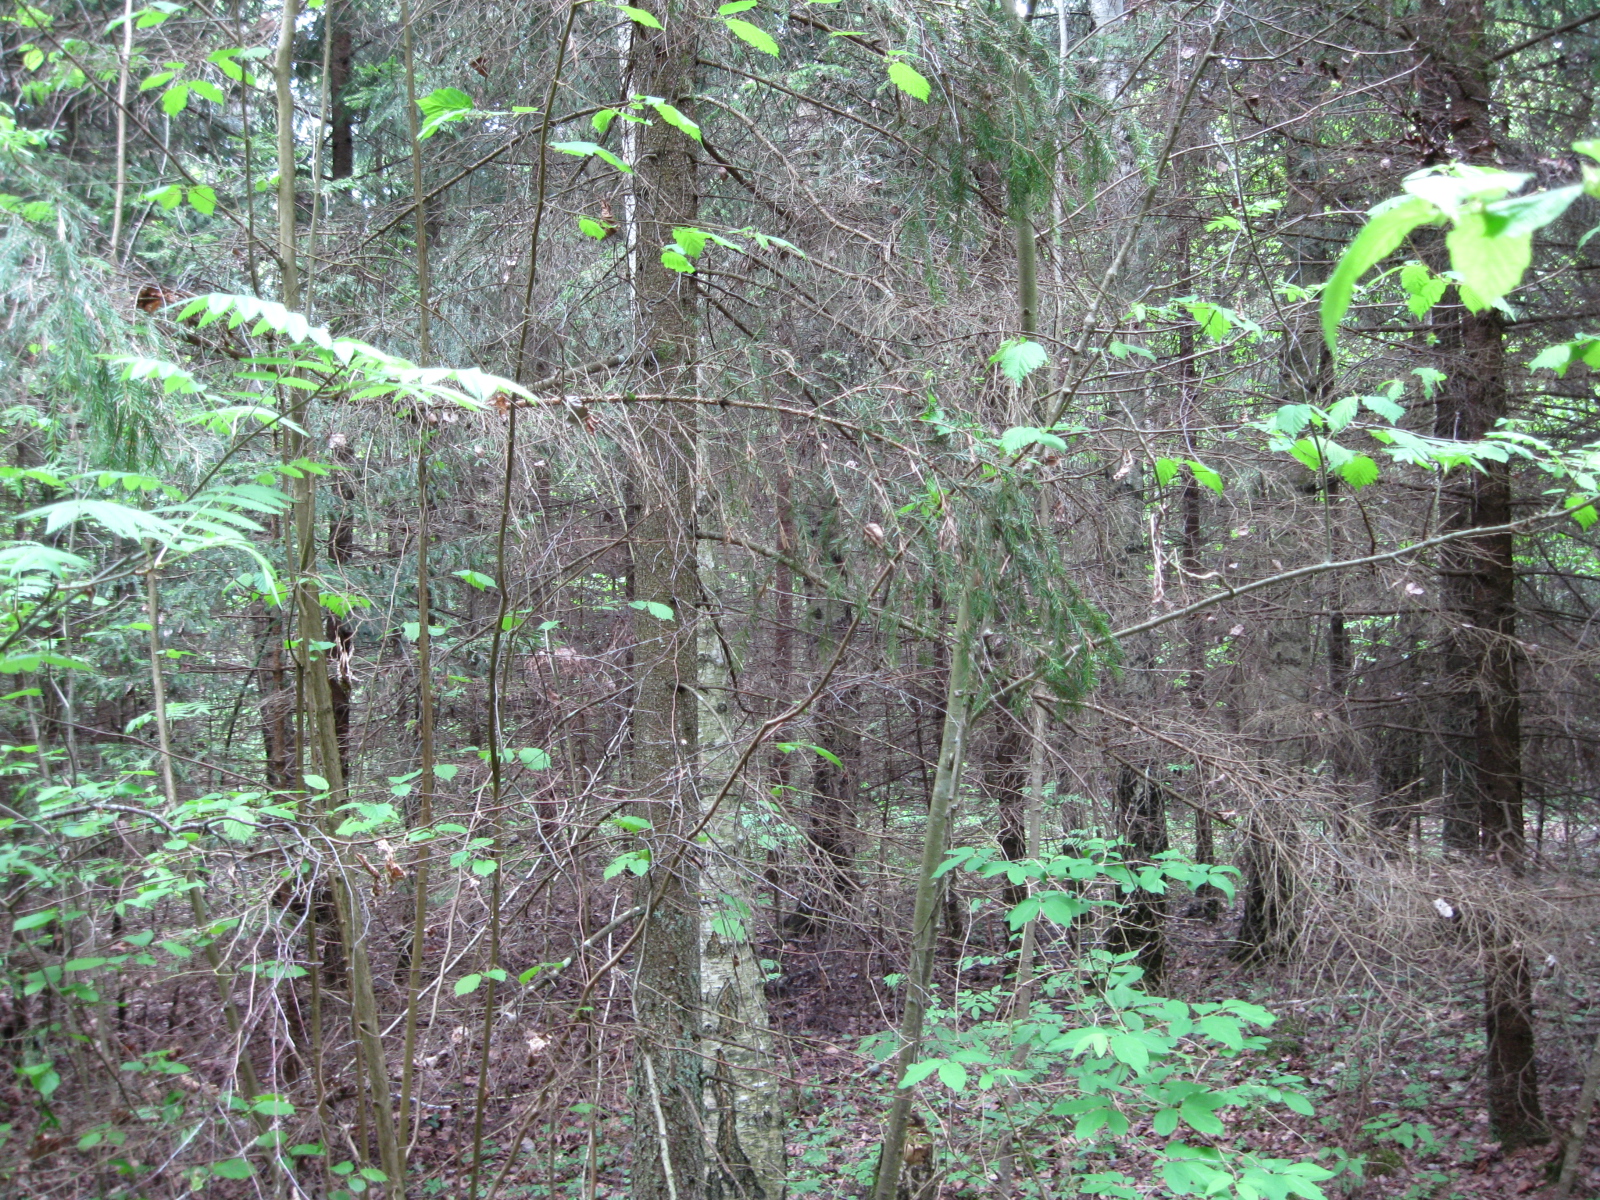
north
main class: Woodland
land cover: Spruce dominated mixed woodland
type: hemiboreal forest and nemoral coniferous forest and mixed broadleaved-coniferous forest
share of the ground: > 75 %
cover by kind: coniferous forest trees 50 %, broadleaved forest trees 40 %, shrubs 5 %, herbaceous plants 5 %
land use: Forestry
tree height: > 5 m
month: May
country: LT
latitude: 56.1330
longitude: 23.4465
